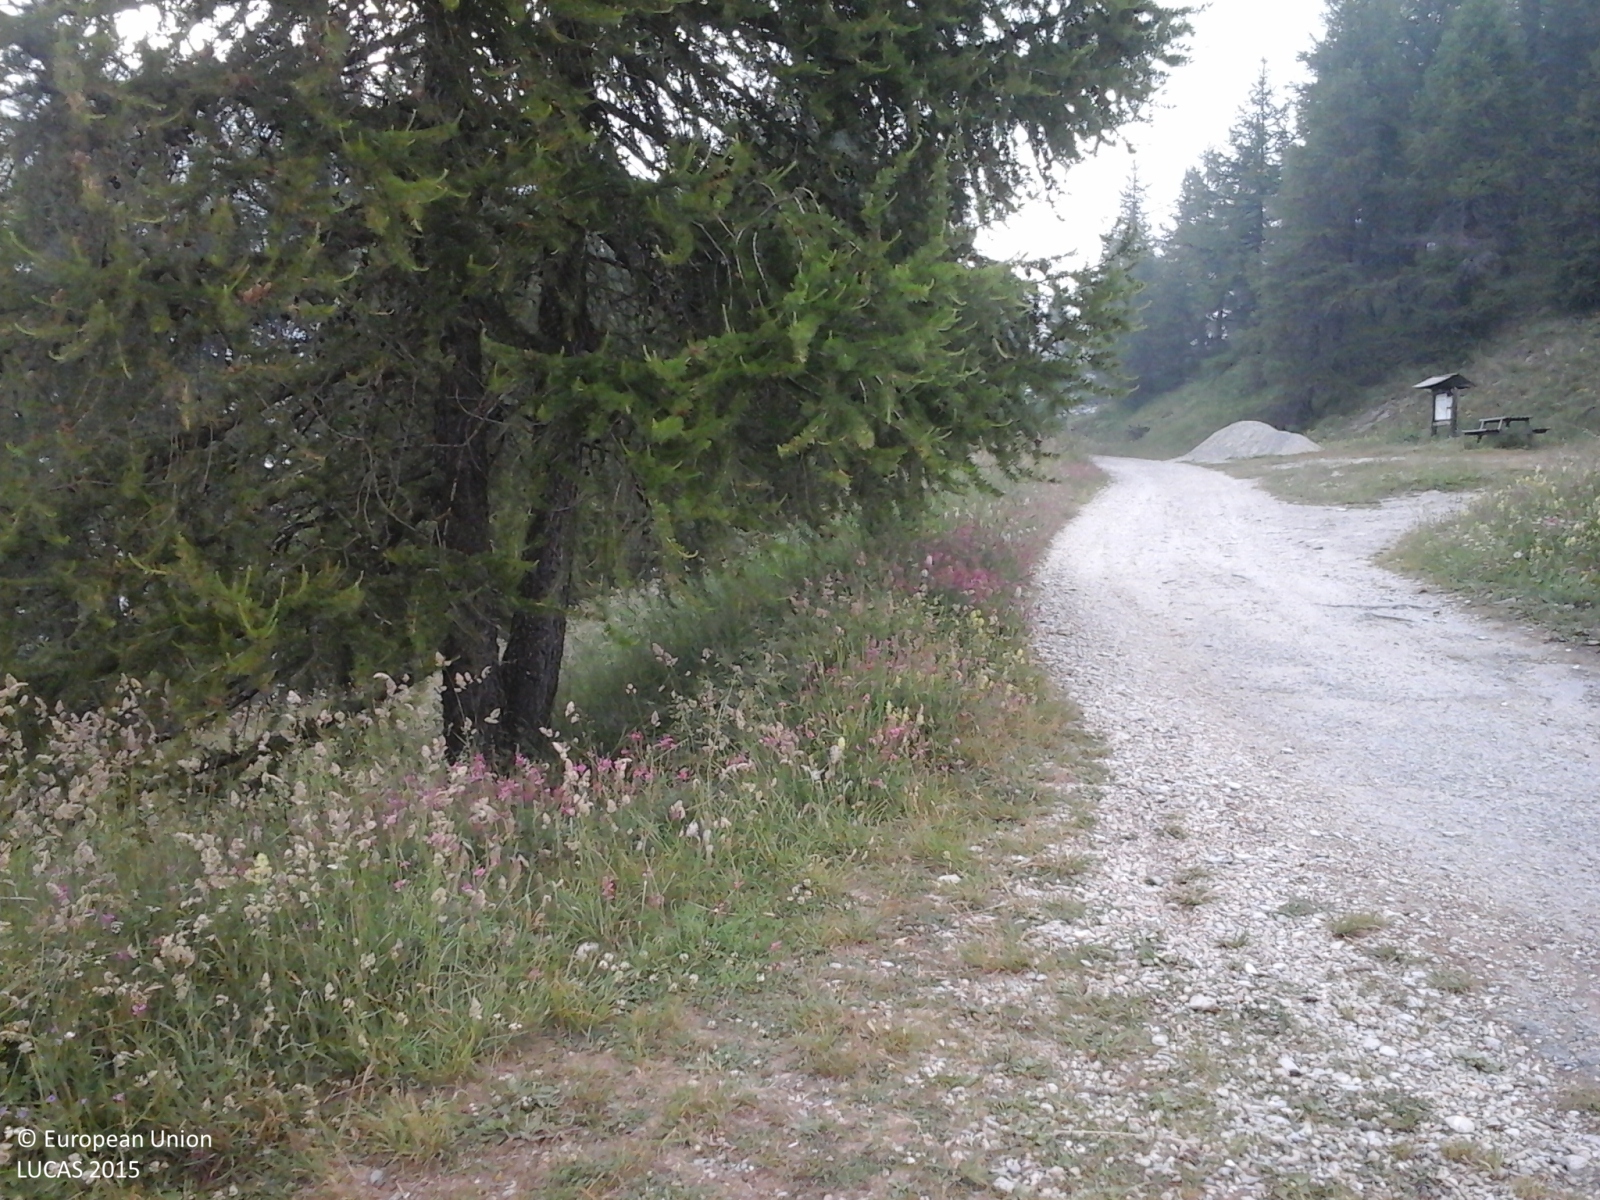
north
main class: Grassland
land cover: Grassland with sparse tree/shrub cover
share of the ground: > 75 %
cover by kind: herbaceous plants 95 %, coniferous forest trees 5 %
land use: Semi-natural and natural areas not in use
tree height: > 5 m
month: July
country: IT
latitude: 45.0483
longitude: 7.0466
